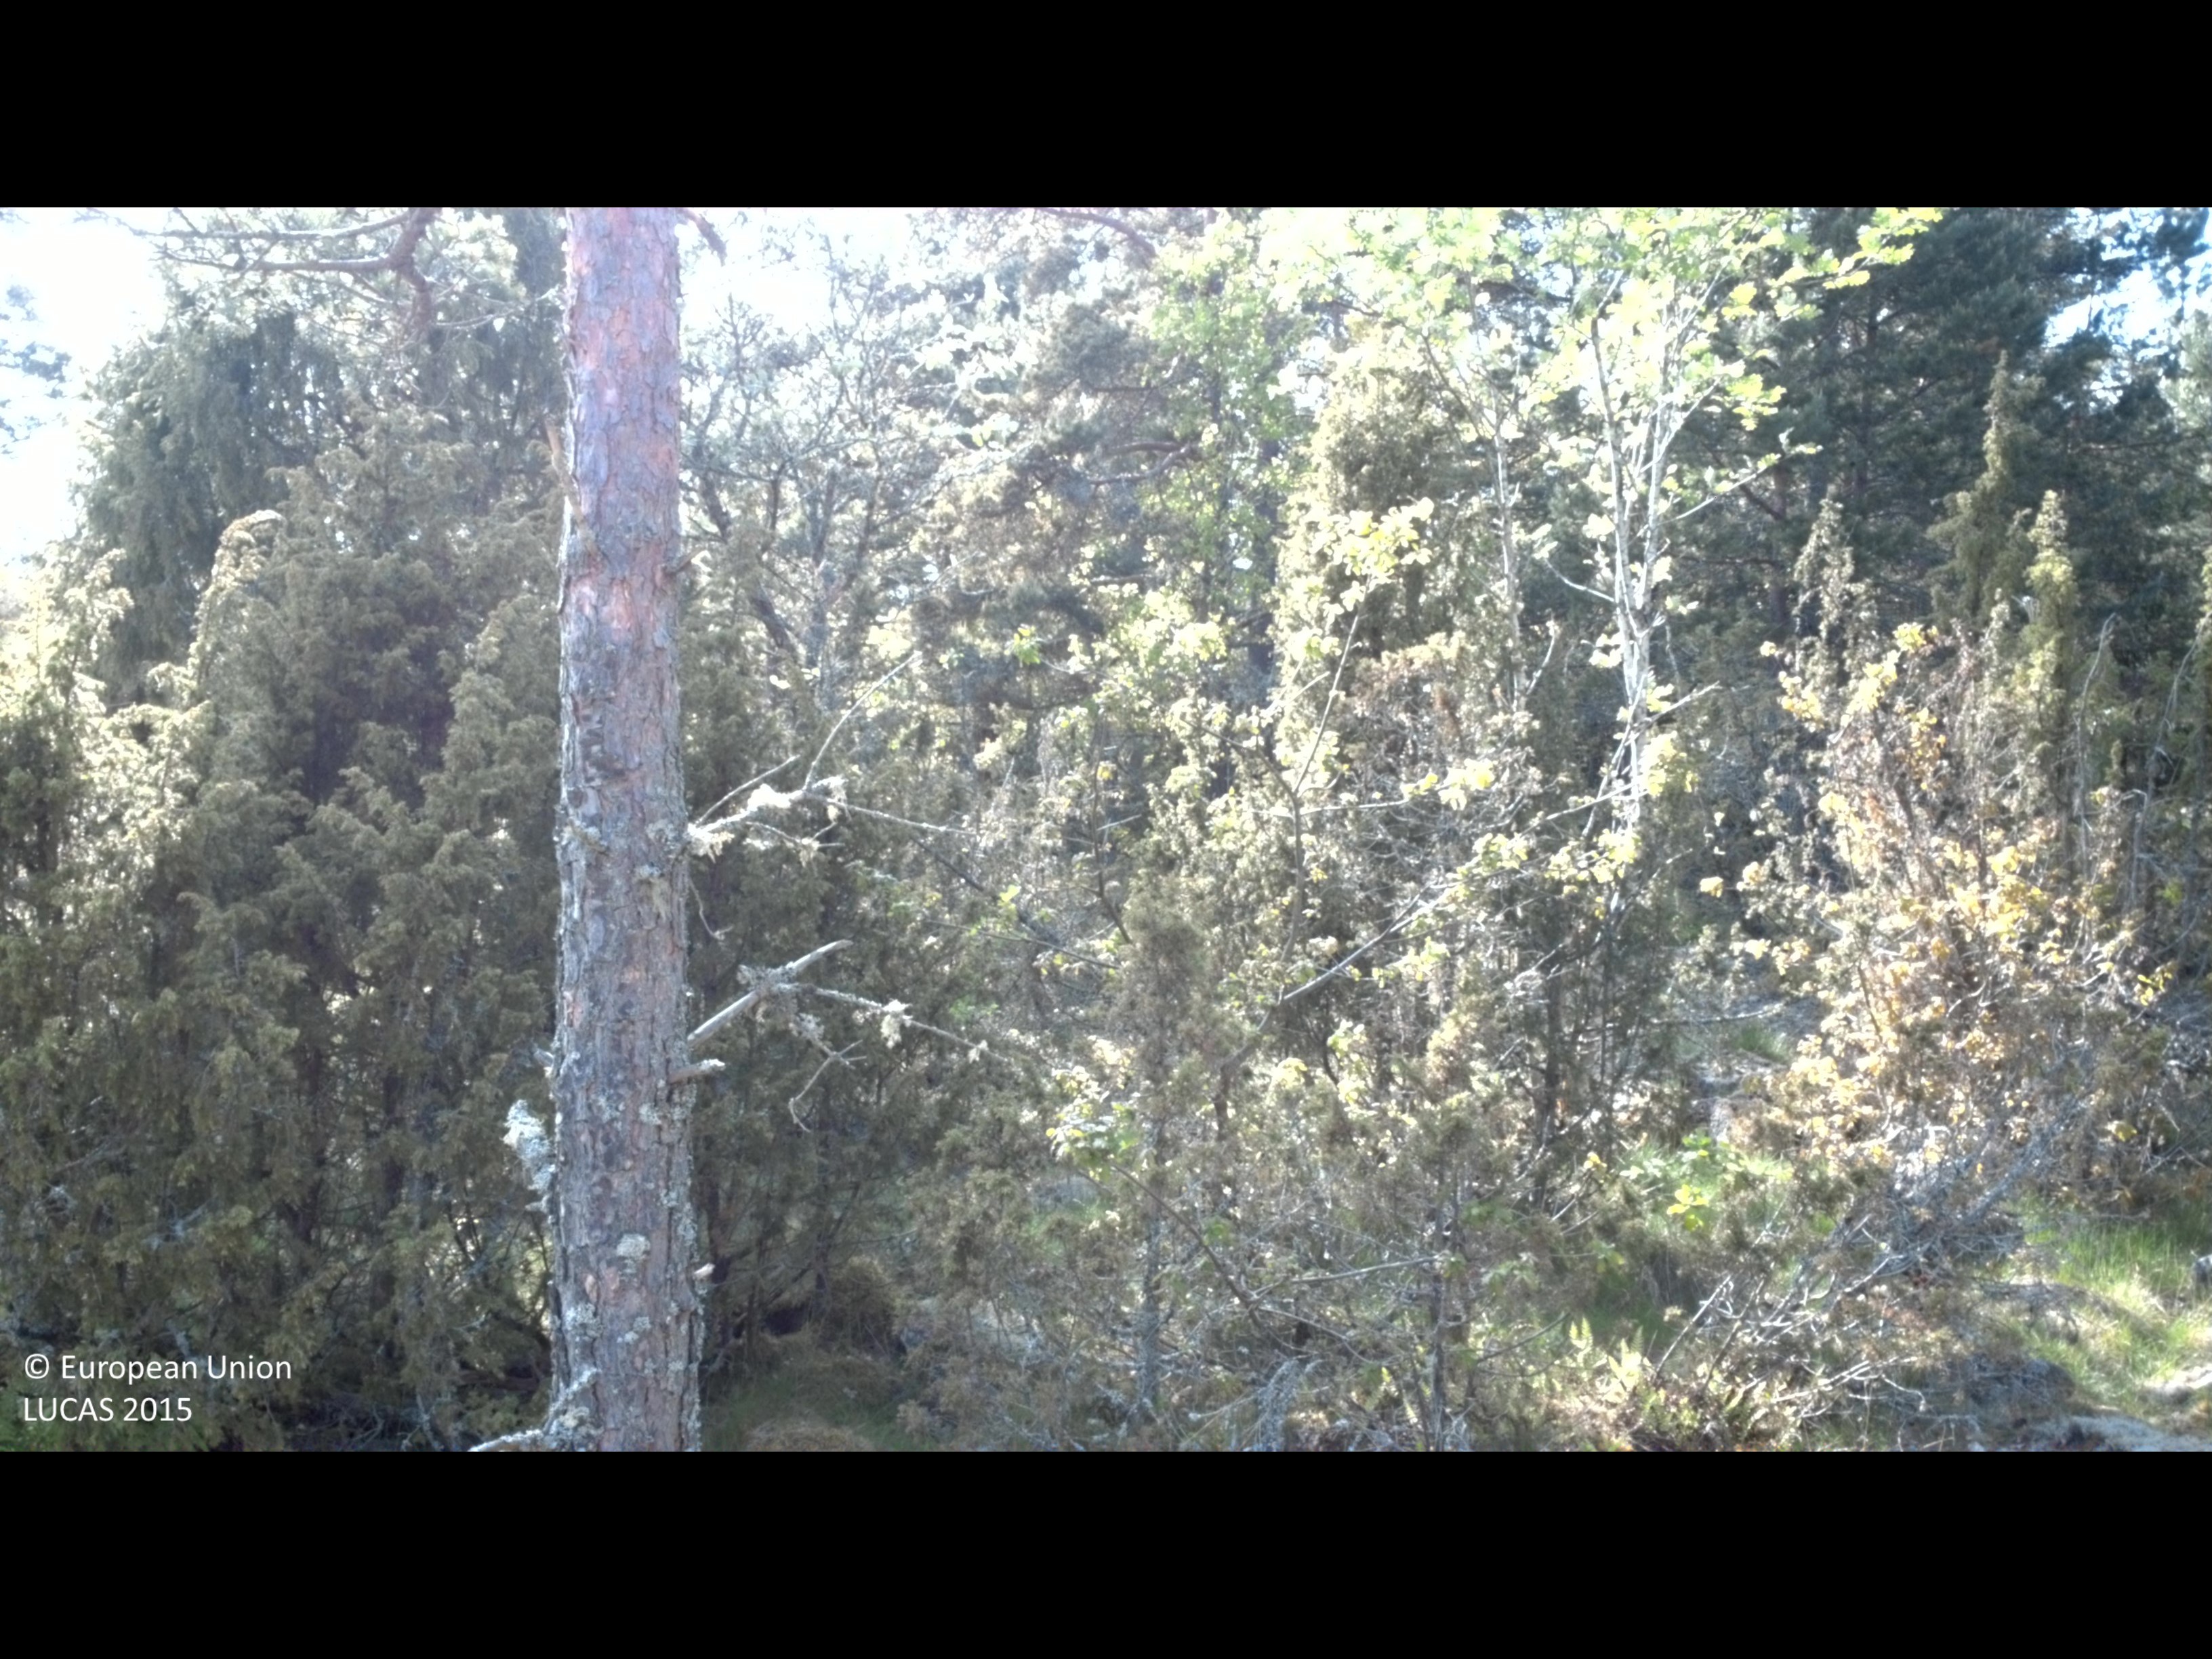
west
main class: Woodland
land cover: Pine dominated coniferous woodland
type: boreal forest
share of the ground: 50 - 75 %
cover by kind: coniferous forest trees 75 %, shrubs 10 %, broadleaved forest trees 5 %, herbaceous plants 5 %, lichens and mosses 5 %
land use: Forestry
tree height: > 5 m
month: May
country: SE
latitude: 57.3892
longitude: 16.6046
